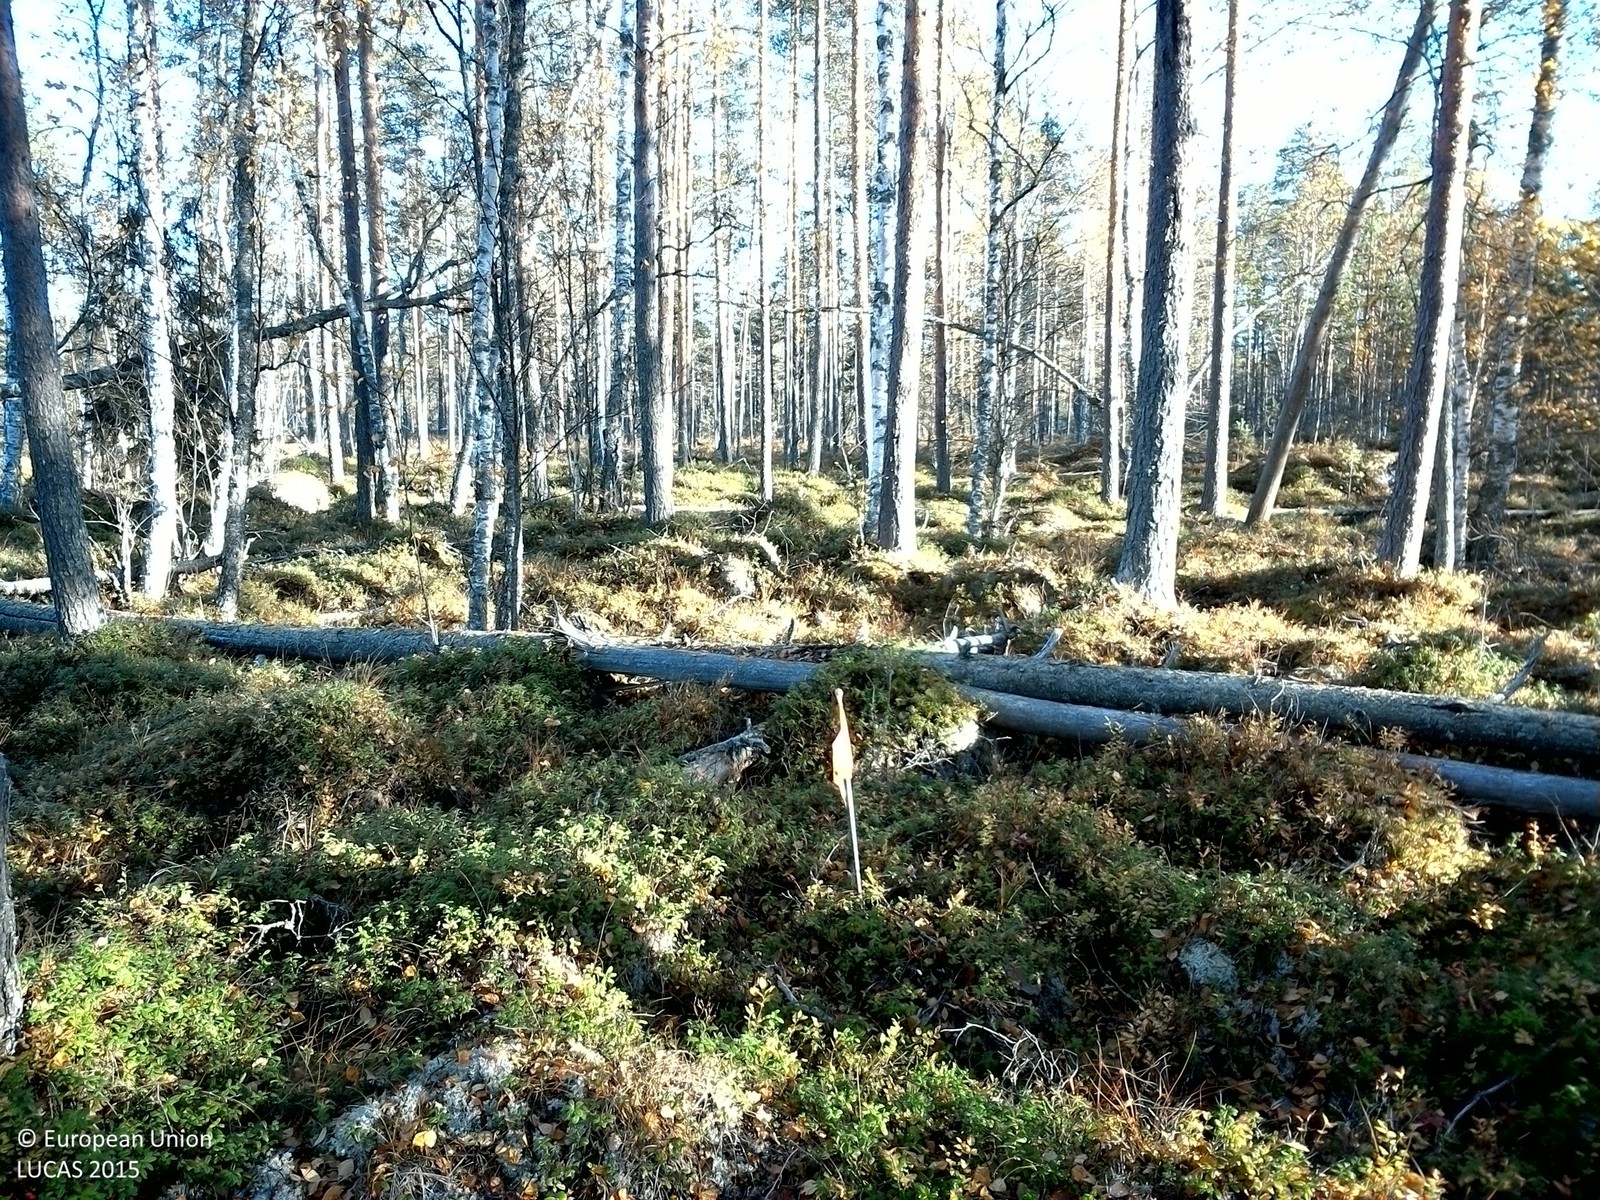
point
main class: Woodland
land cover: Pine dominated mixed woodland
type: boreal forest
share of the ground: 50 - 75 %
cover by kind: coniferous forest trees 35 %, shrubs 25 %, broadleaved forest trees 20 %, lichens and mosses 10 %, consolidated bare surface 10 %
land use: Forestry
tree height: > 5 m
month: October
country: SE
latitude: 61.3702
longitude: 15.0923
